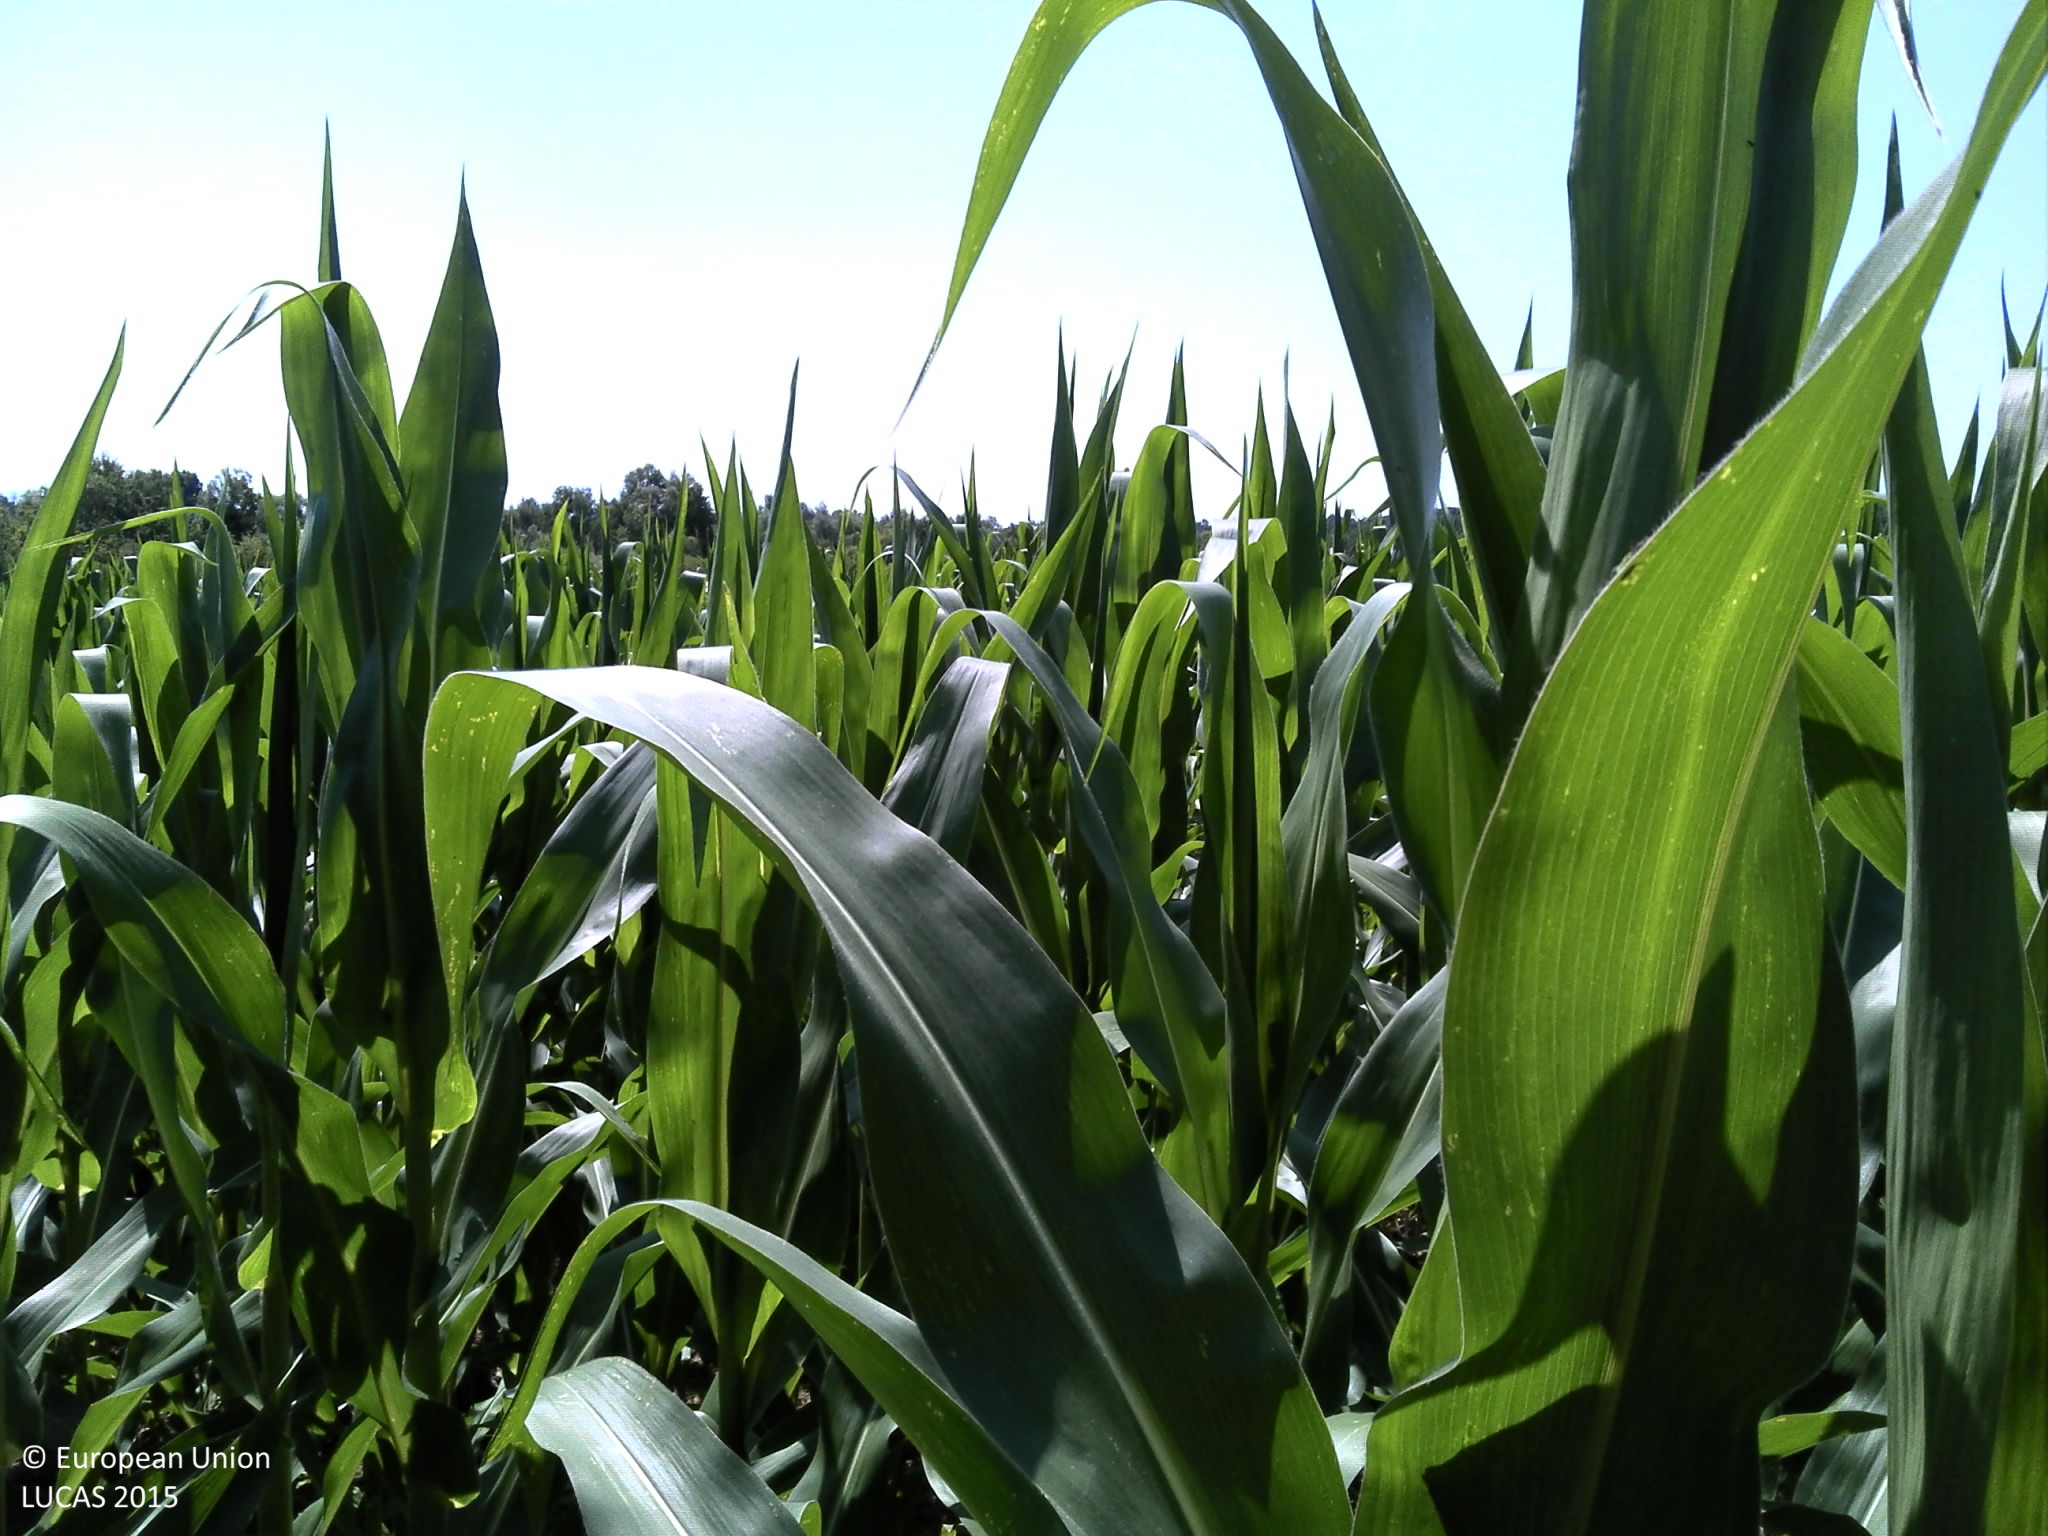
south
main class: Cropland
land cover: Maize
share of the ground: > 75 %
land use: Agriculture (excluding fallow land and kitchen gardens)
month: July
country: HR
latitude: 45.5153
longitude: 16.8735
